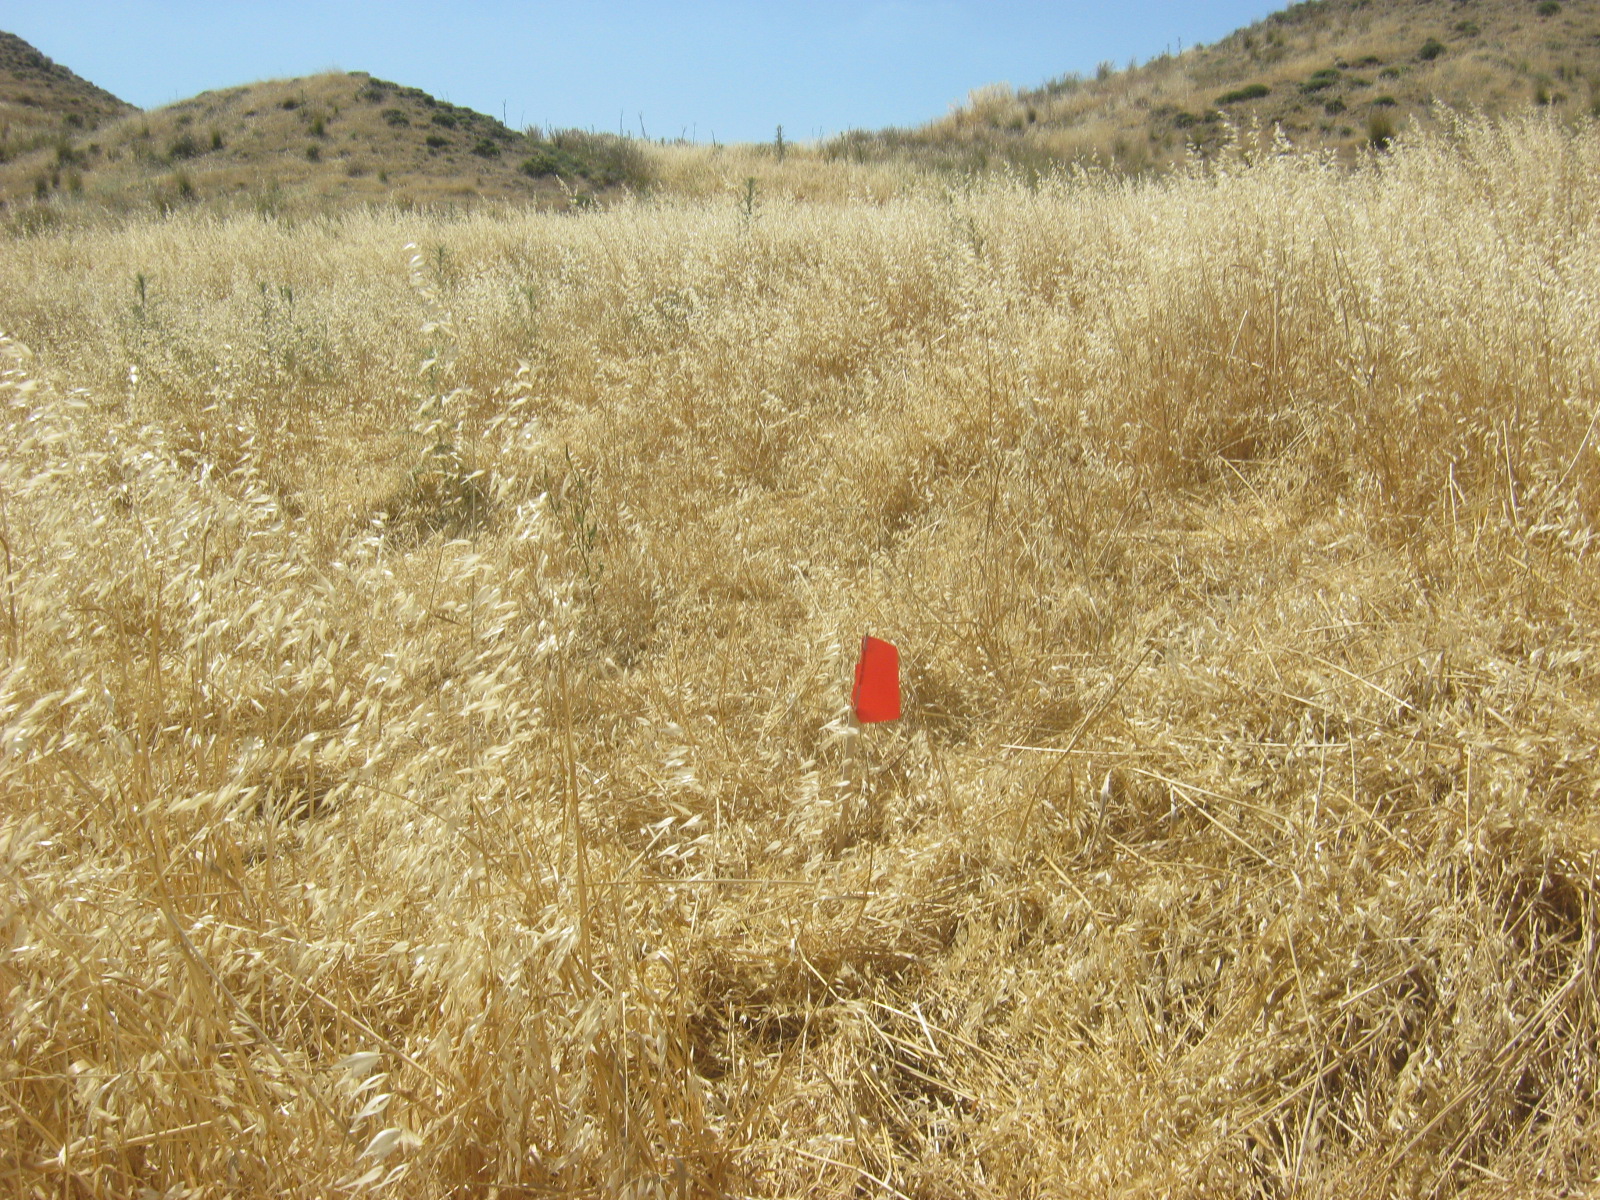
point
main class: Grassland
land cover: Spontaneously vegetated surfaces
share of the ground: > 75 %
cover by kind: herbaceous plants 100 %
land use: Semi-natural and natural areas not in use
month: May
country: CY
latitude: 35.0963
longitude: 33.2107
